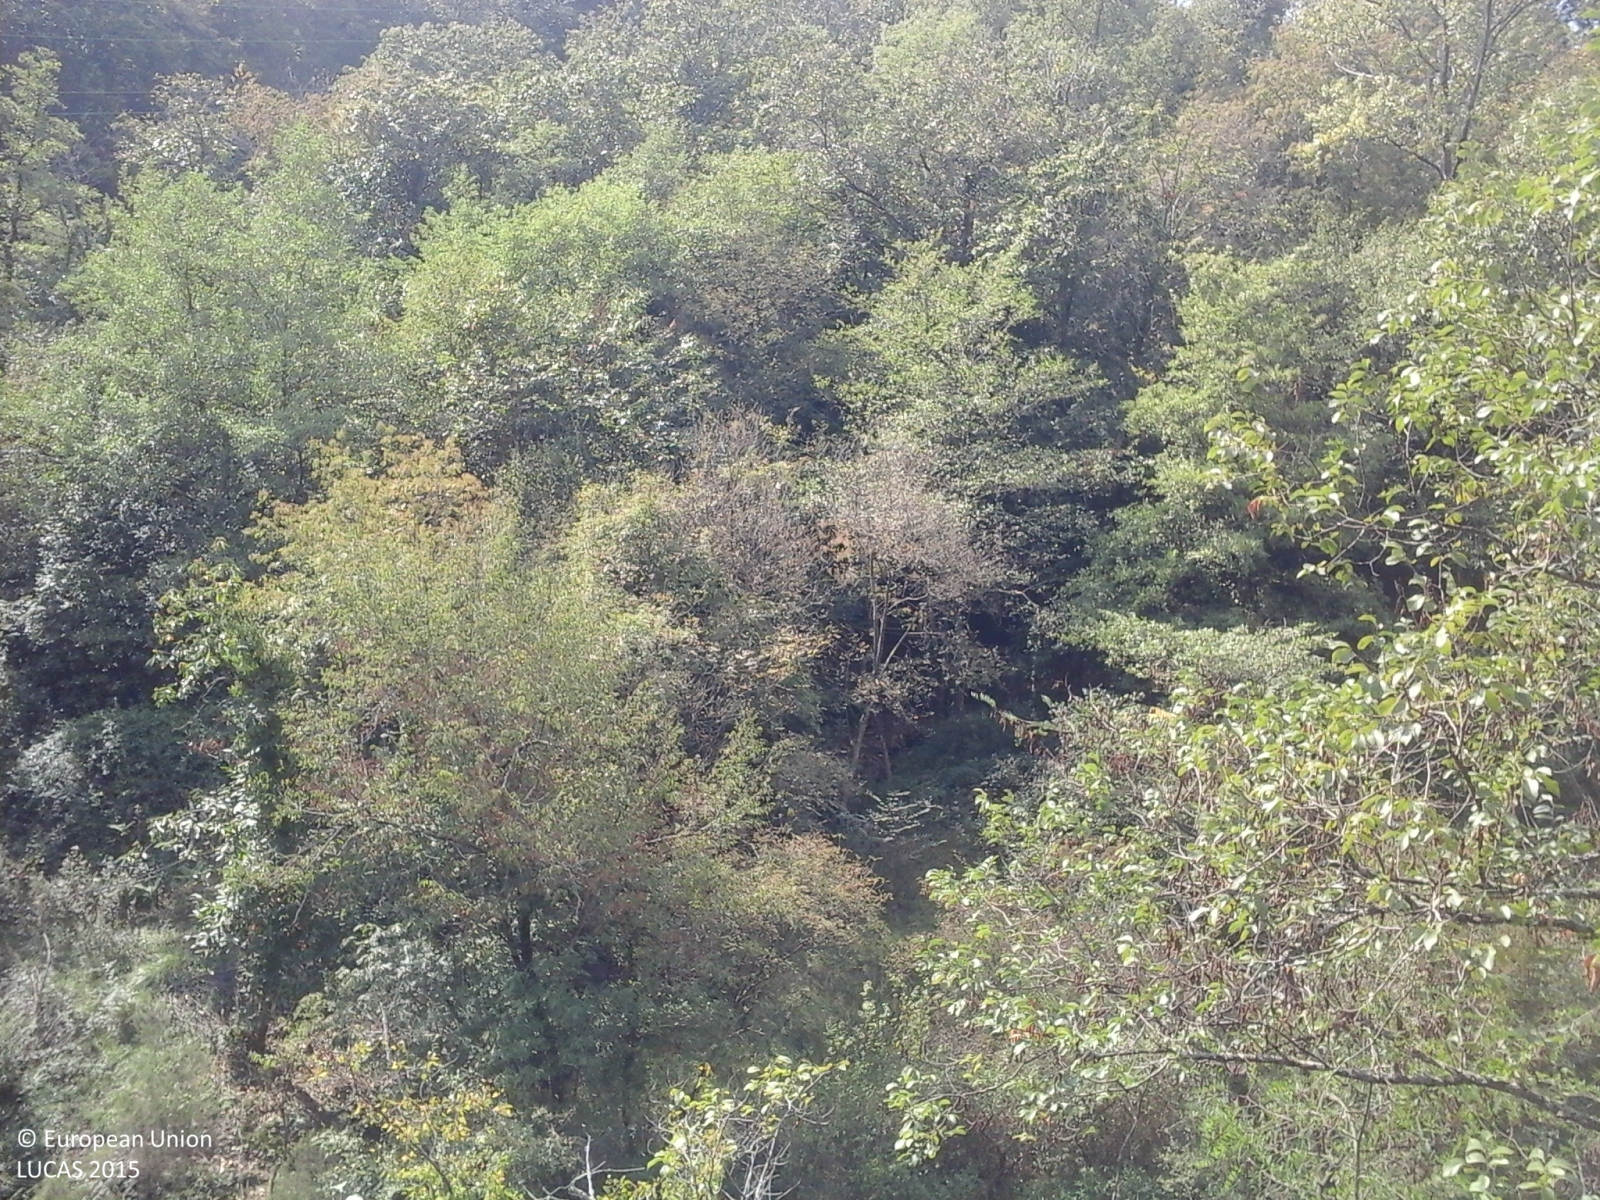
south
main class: Woodland
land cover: Broadleaved woodland
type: thermophilous deciduous forest
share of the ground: > 75 %
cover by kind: broadleaved forest trees 100 %
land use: Semi-natural and natural areas not in use
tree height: > 5 m
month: September
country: IT
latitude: 44.4373
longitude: 9.1601
